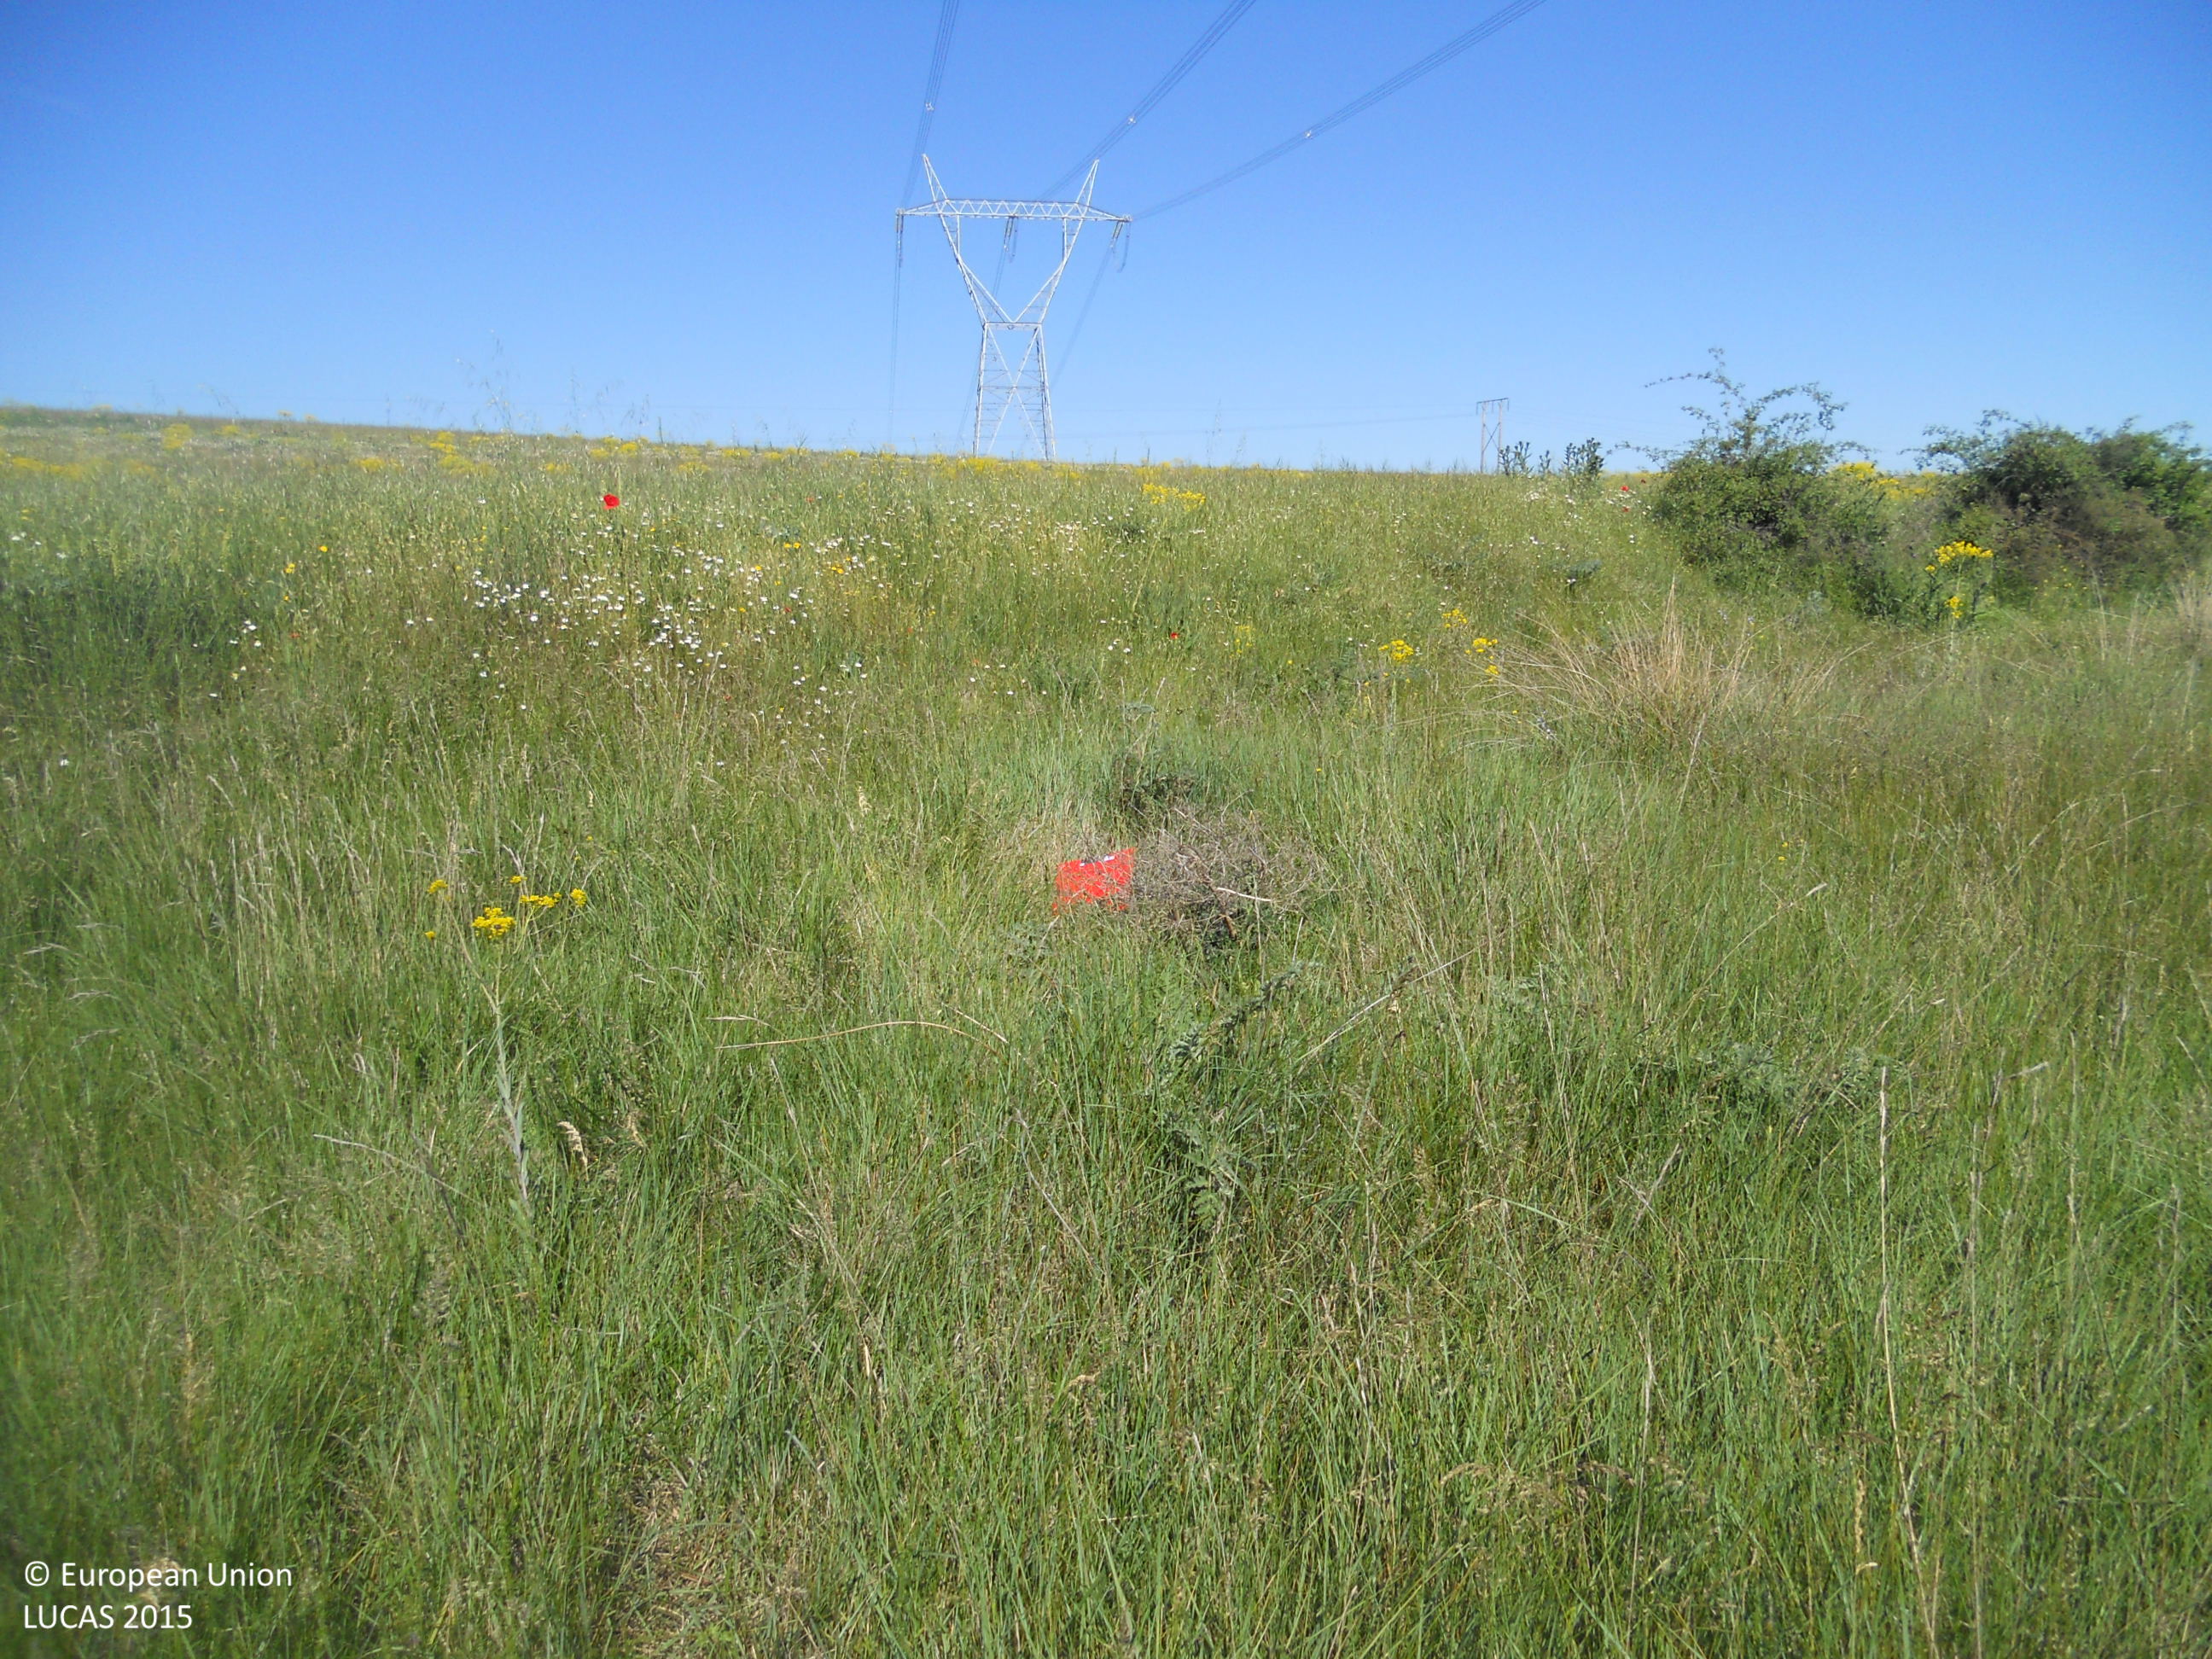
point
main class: Grassland
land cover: Grassland without tree/shrub cover
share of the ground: > 75 %
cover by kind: herbaceous plants 100 %
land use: Semi-natural and natural areas not in use
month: May
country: ES
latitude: 42.4504
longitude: -5.5737
